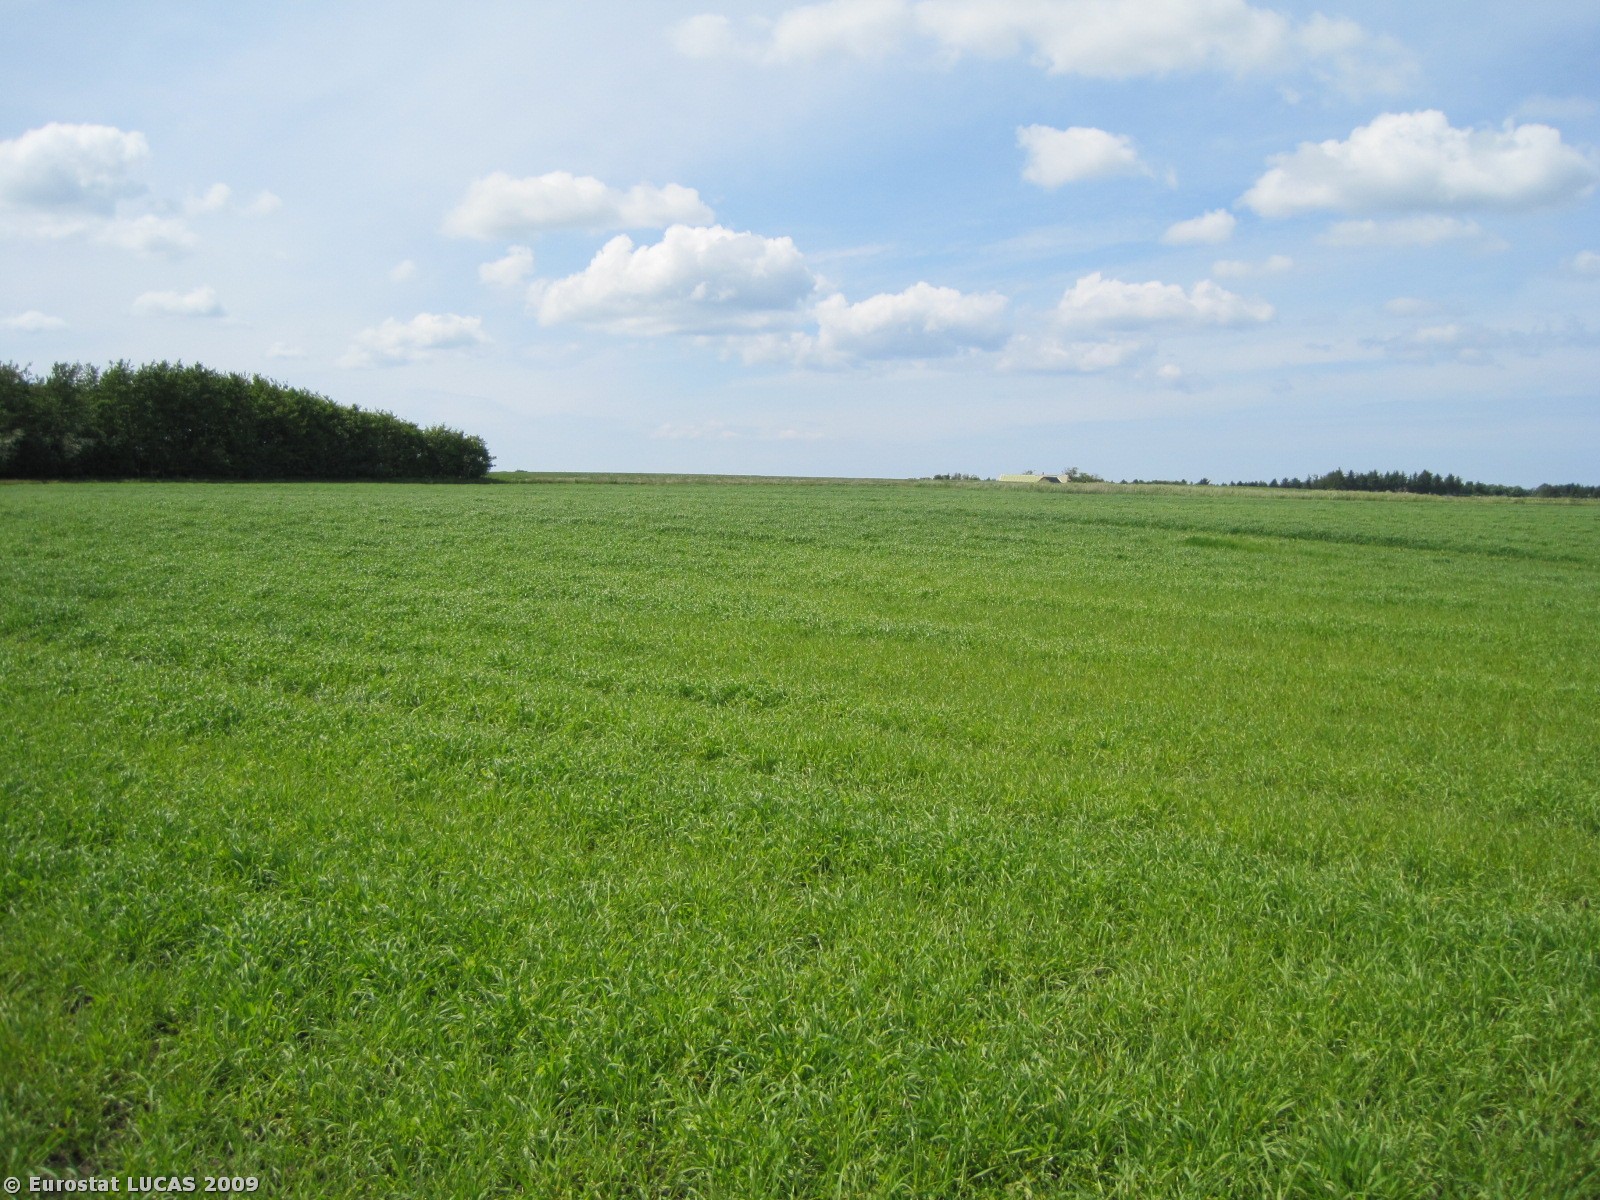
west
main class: Cropland
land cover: Barley
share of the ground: > 75 %
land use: Agriculture (excluding fallow land and kitchen gardens)
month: June
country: DK
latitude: 57.3561
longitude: 9.7843
